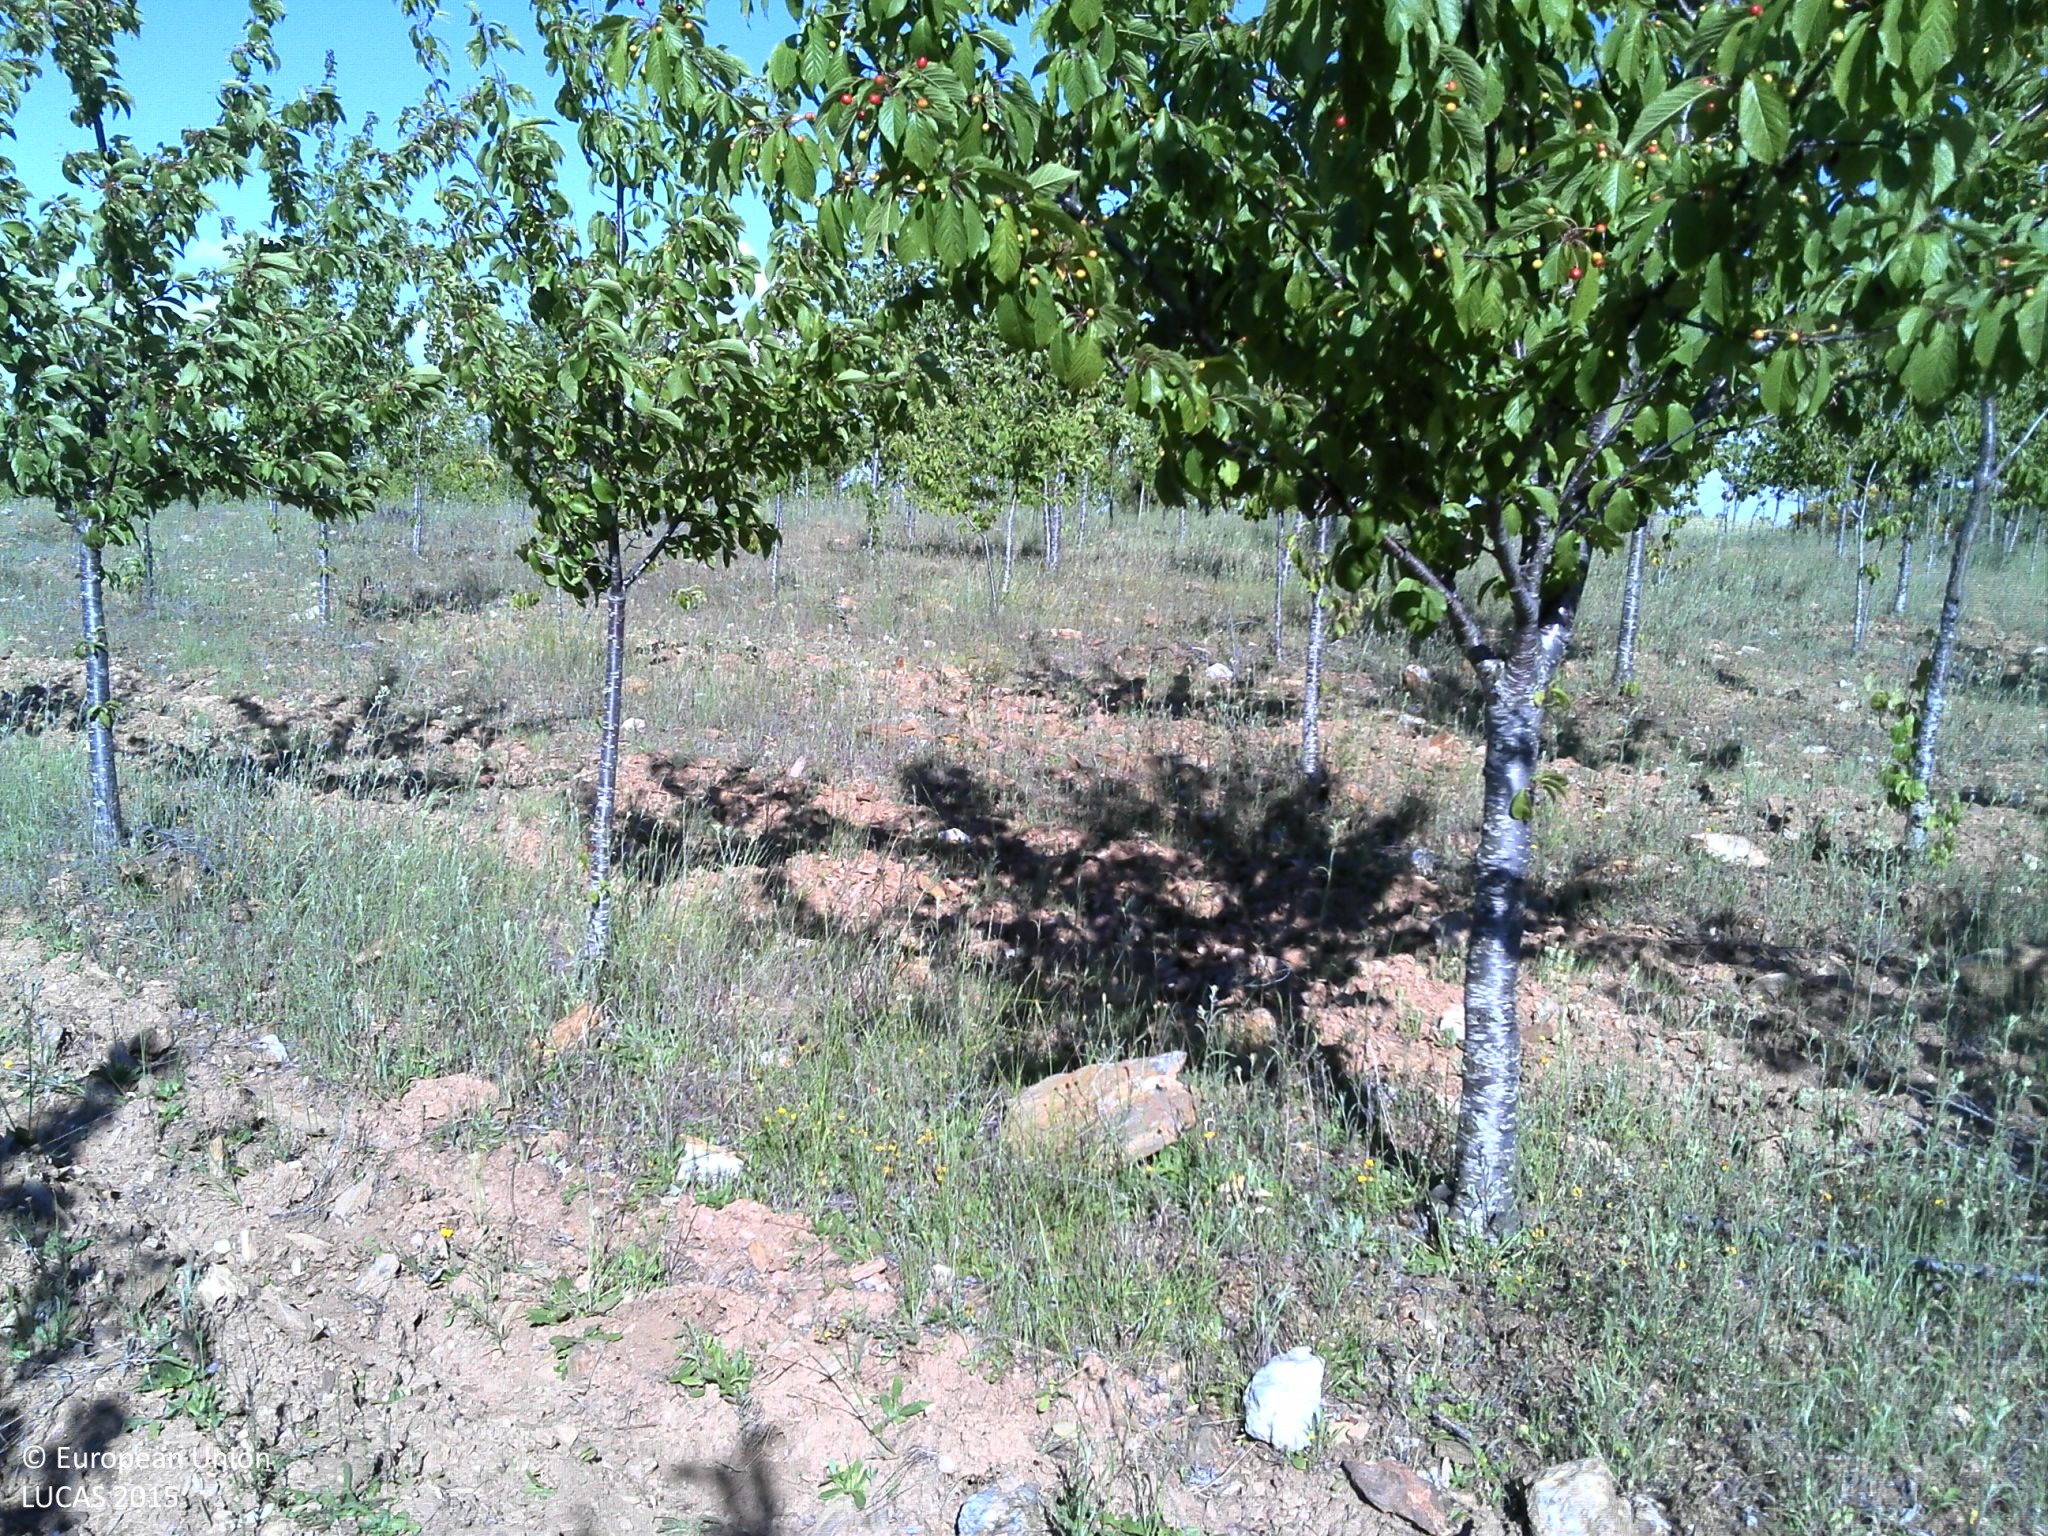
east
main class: Cropland
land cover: Cherry fruit
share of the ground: 25 - 50 %
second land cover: Spontaneously vegetated surfaces
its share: 25 - 50 %
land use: Agriculture (excluding fallow land and kitchen gardens)
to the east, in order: Cherry fruit; Spontaneously vegetated surfaces; Other bare soil; Grass margins; Other bare soil; Shrubland without tree cover; Other bare soil; Spontaneously vegetated surfaces
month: May
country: PT
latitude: 41.6564
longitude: -6.3981
